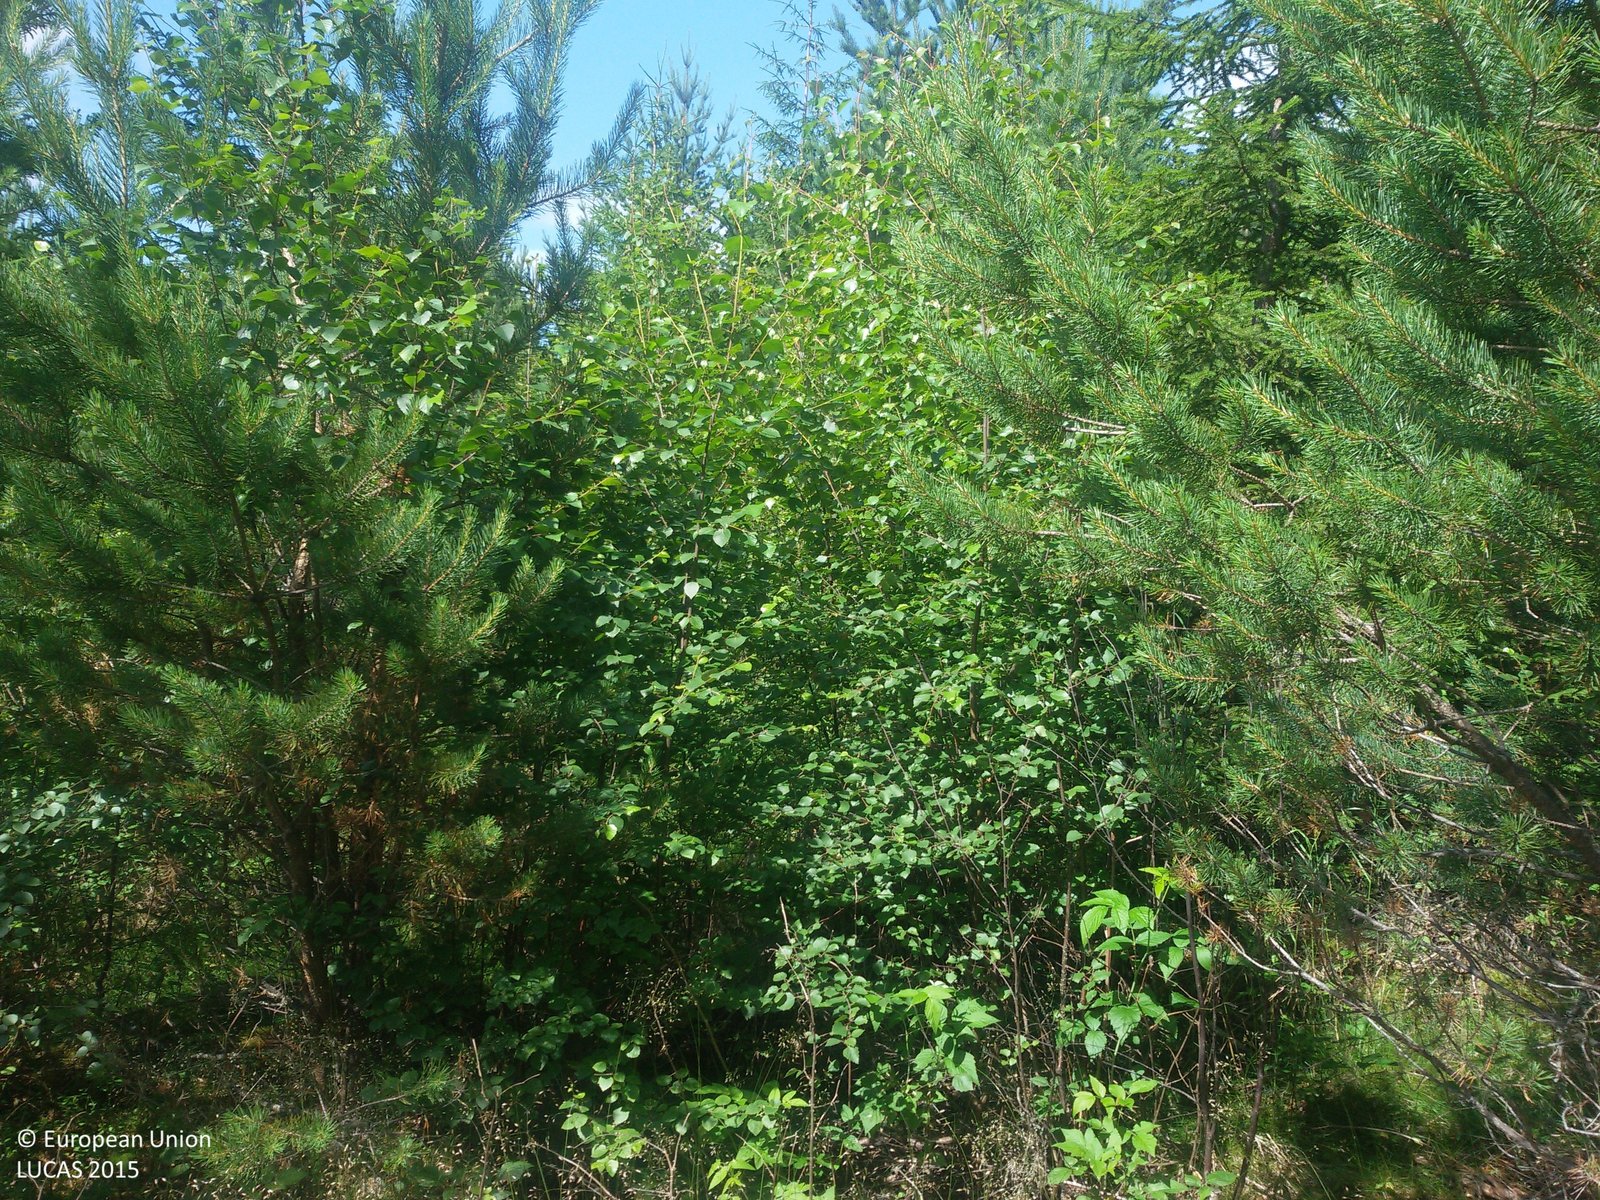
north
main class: Woodland
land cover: Pine dominated mixed woodland
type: boreal forest
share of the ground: > 75 %
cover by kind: coniferous forest trees 70 %, broadleaved forest trees 30 %
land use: Forestry
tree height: < 5 m
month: July
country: SE
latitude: 60.4726
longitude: 14.9538
